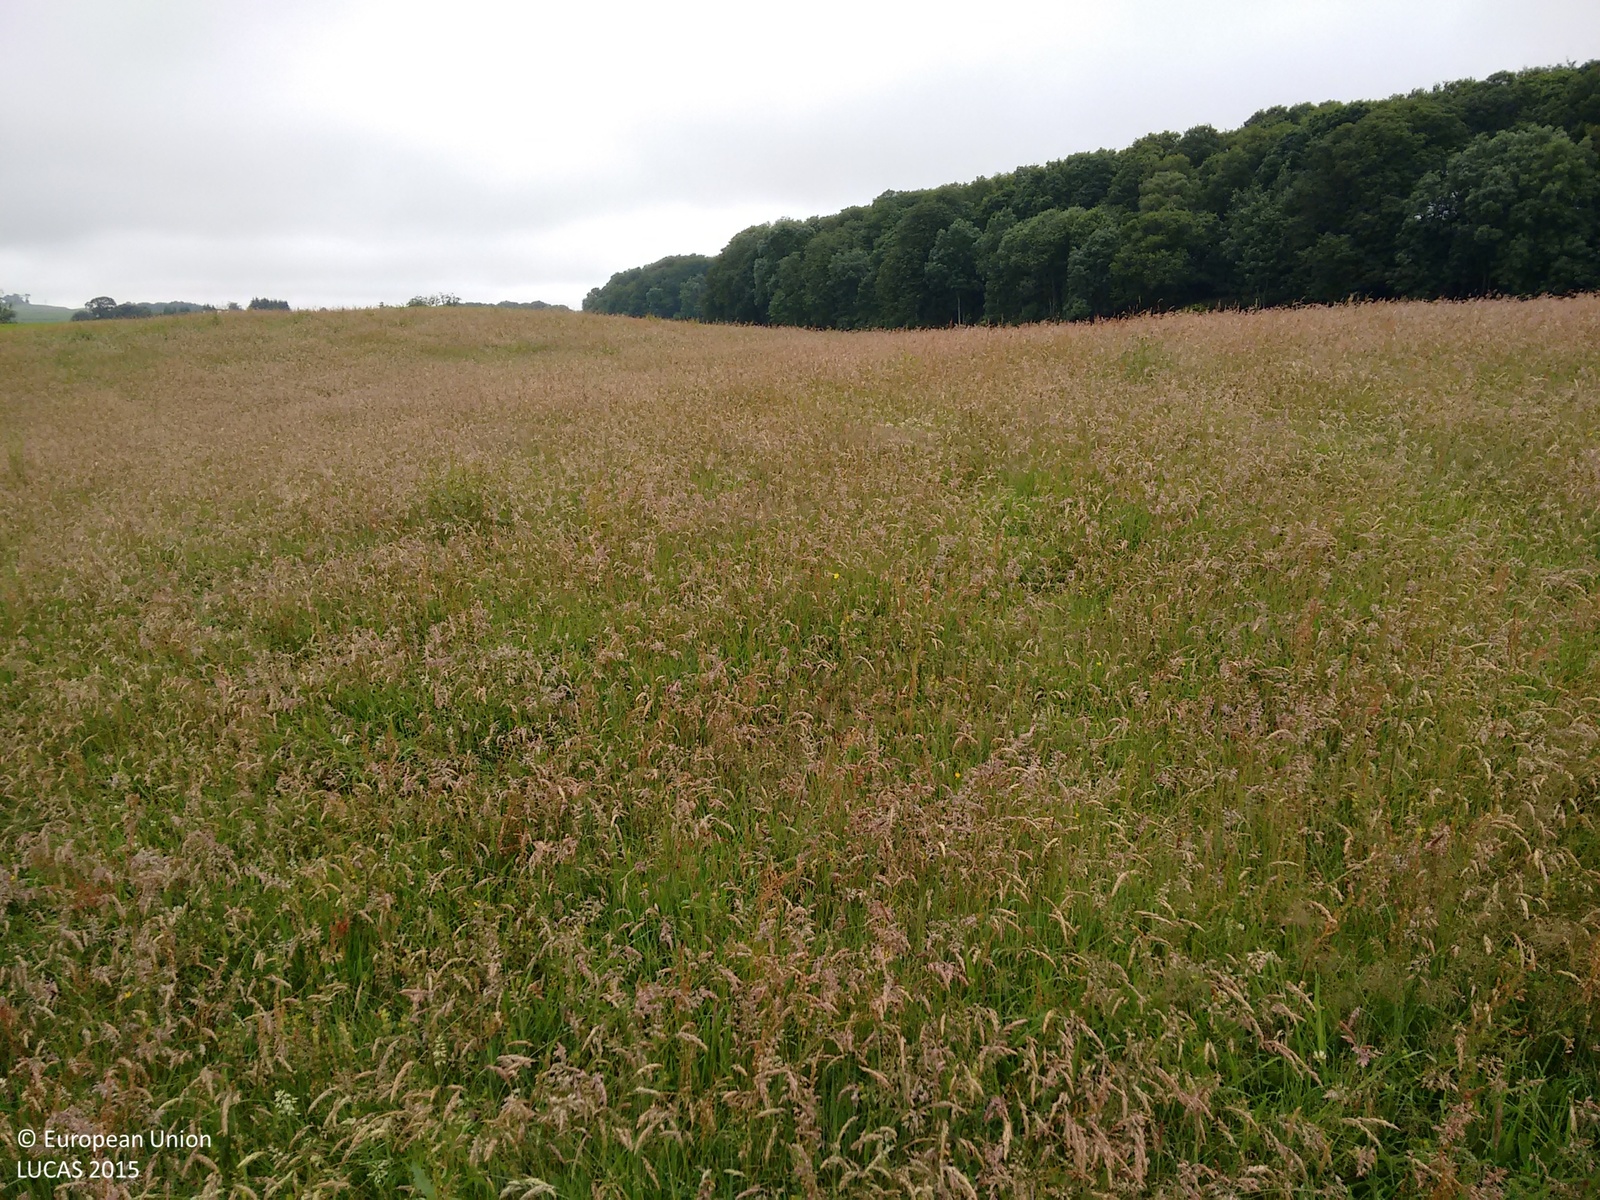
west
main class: Grassland
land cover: Grassland without tree/shrub cover
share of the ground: > 75 %
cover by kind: herbaceous plants 100 %
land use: Agriculture (excluding fallow land and kitchen gardens)
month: July
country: GB
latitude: 54.9399
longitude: -3.9991
